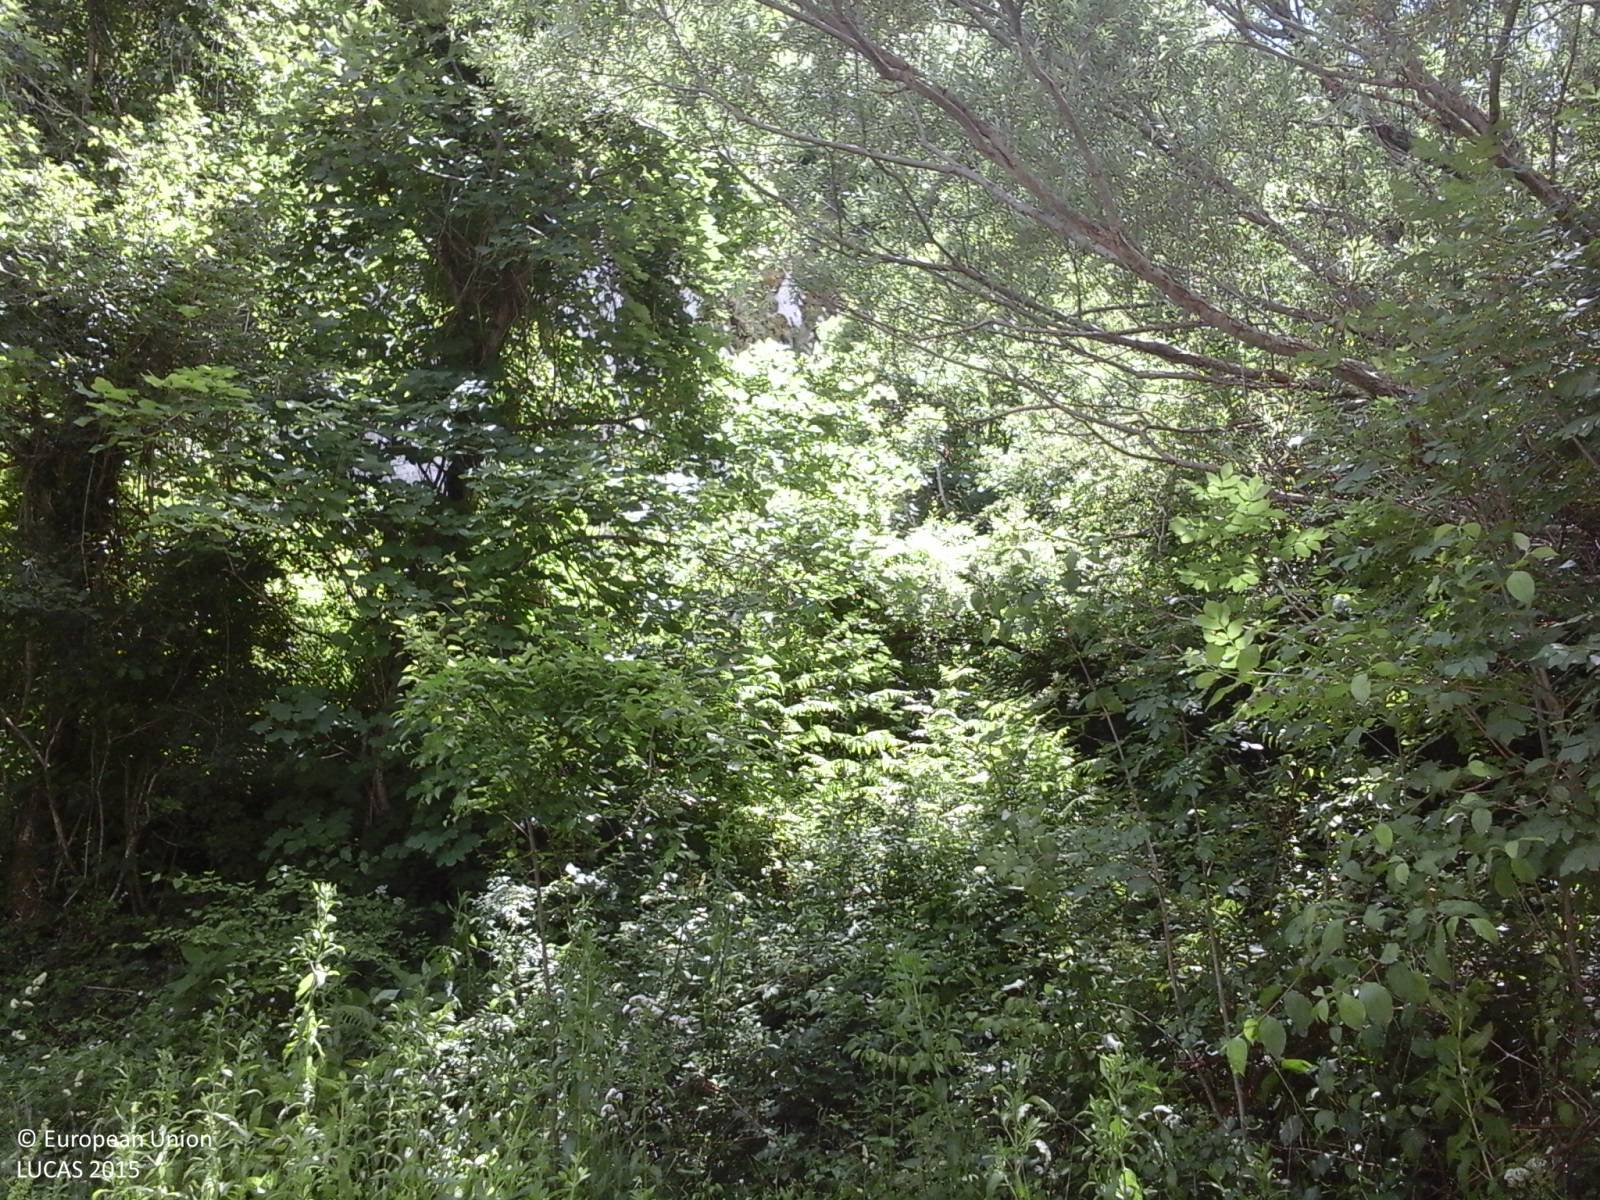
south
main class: Woodland
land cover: Broadleaved woodland
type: thermophilous deciduous forest
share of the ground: > 75 %
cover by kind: broadleaved forest trees 100 %
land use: Semi-natural and natural areas not in use
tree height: < 5 m
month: June
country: IT
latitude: 41.4418
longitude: 14.2810
